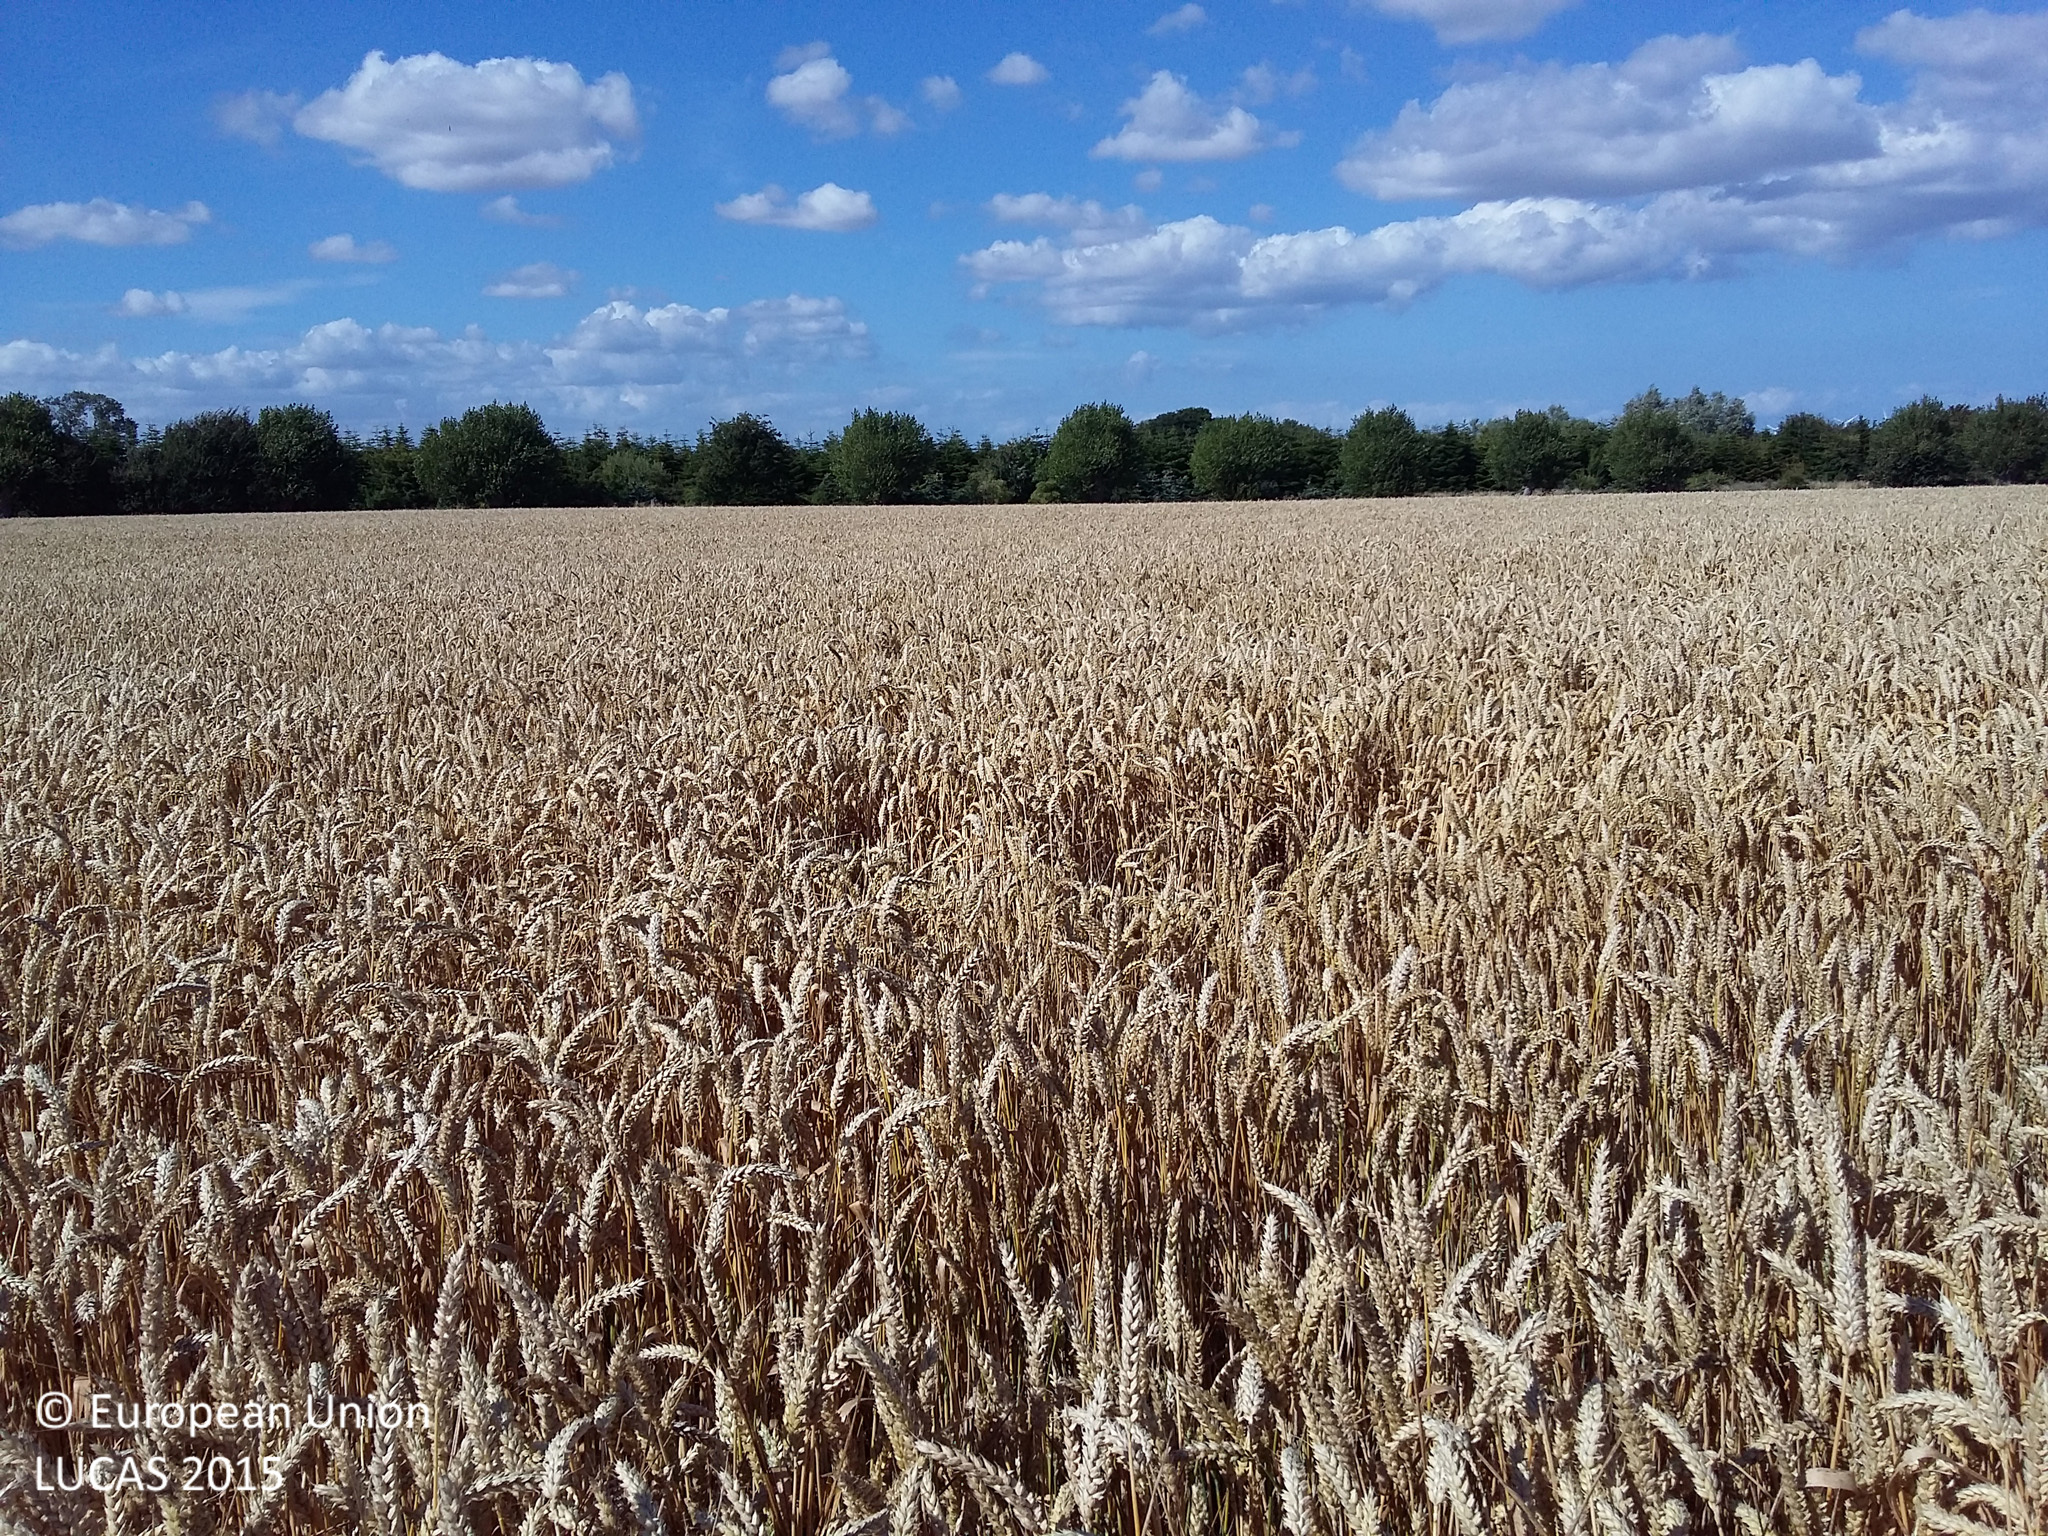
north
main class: Cropland
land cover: Common wheat
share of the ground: > 75 %
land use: Agriculture (excluding fallow land and kitchen gardens)
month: August
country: DK
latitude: 55.2499
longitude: 12.3109
